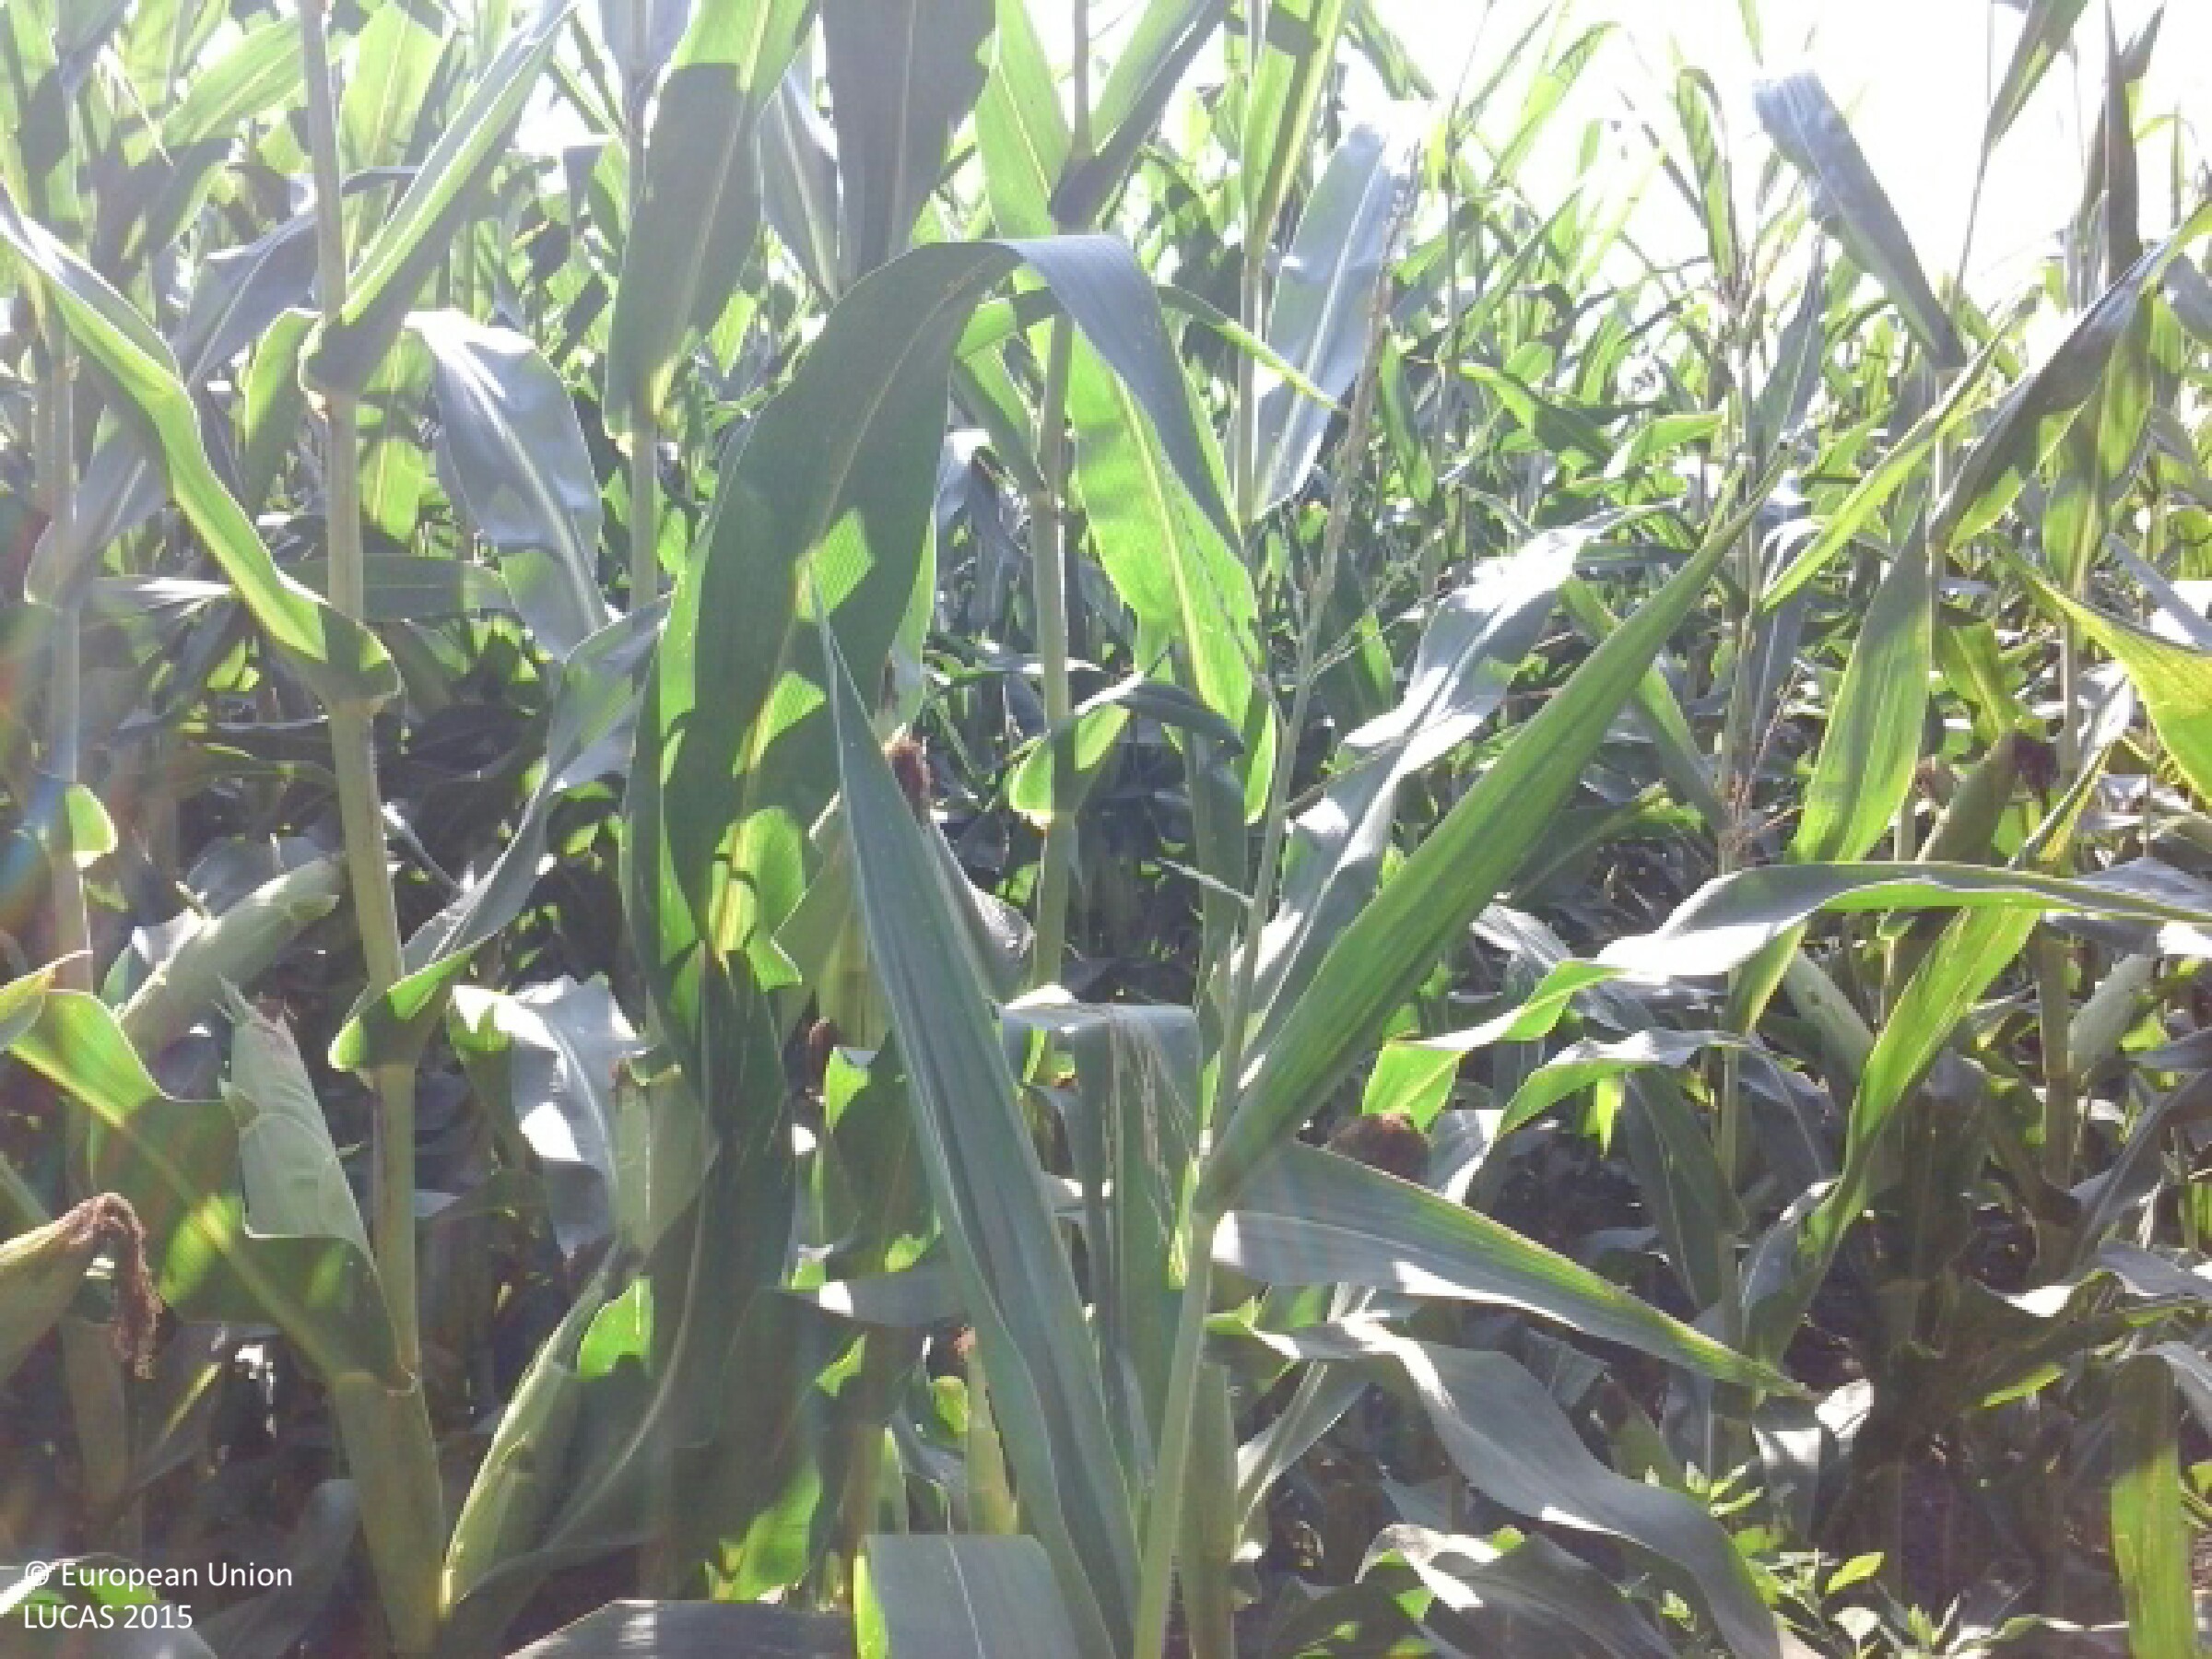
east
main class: Cropland
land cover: Maize
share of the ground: > 75 %
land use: Agriculture (excluding fallow land and kitchen gardens)
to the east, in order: Maize
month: August
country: HU
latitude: 47.5549
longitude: 17.9709
